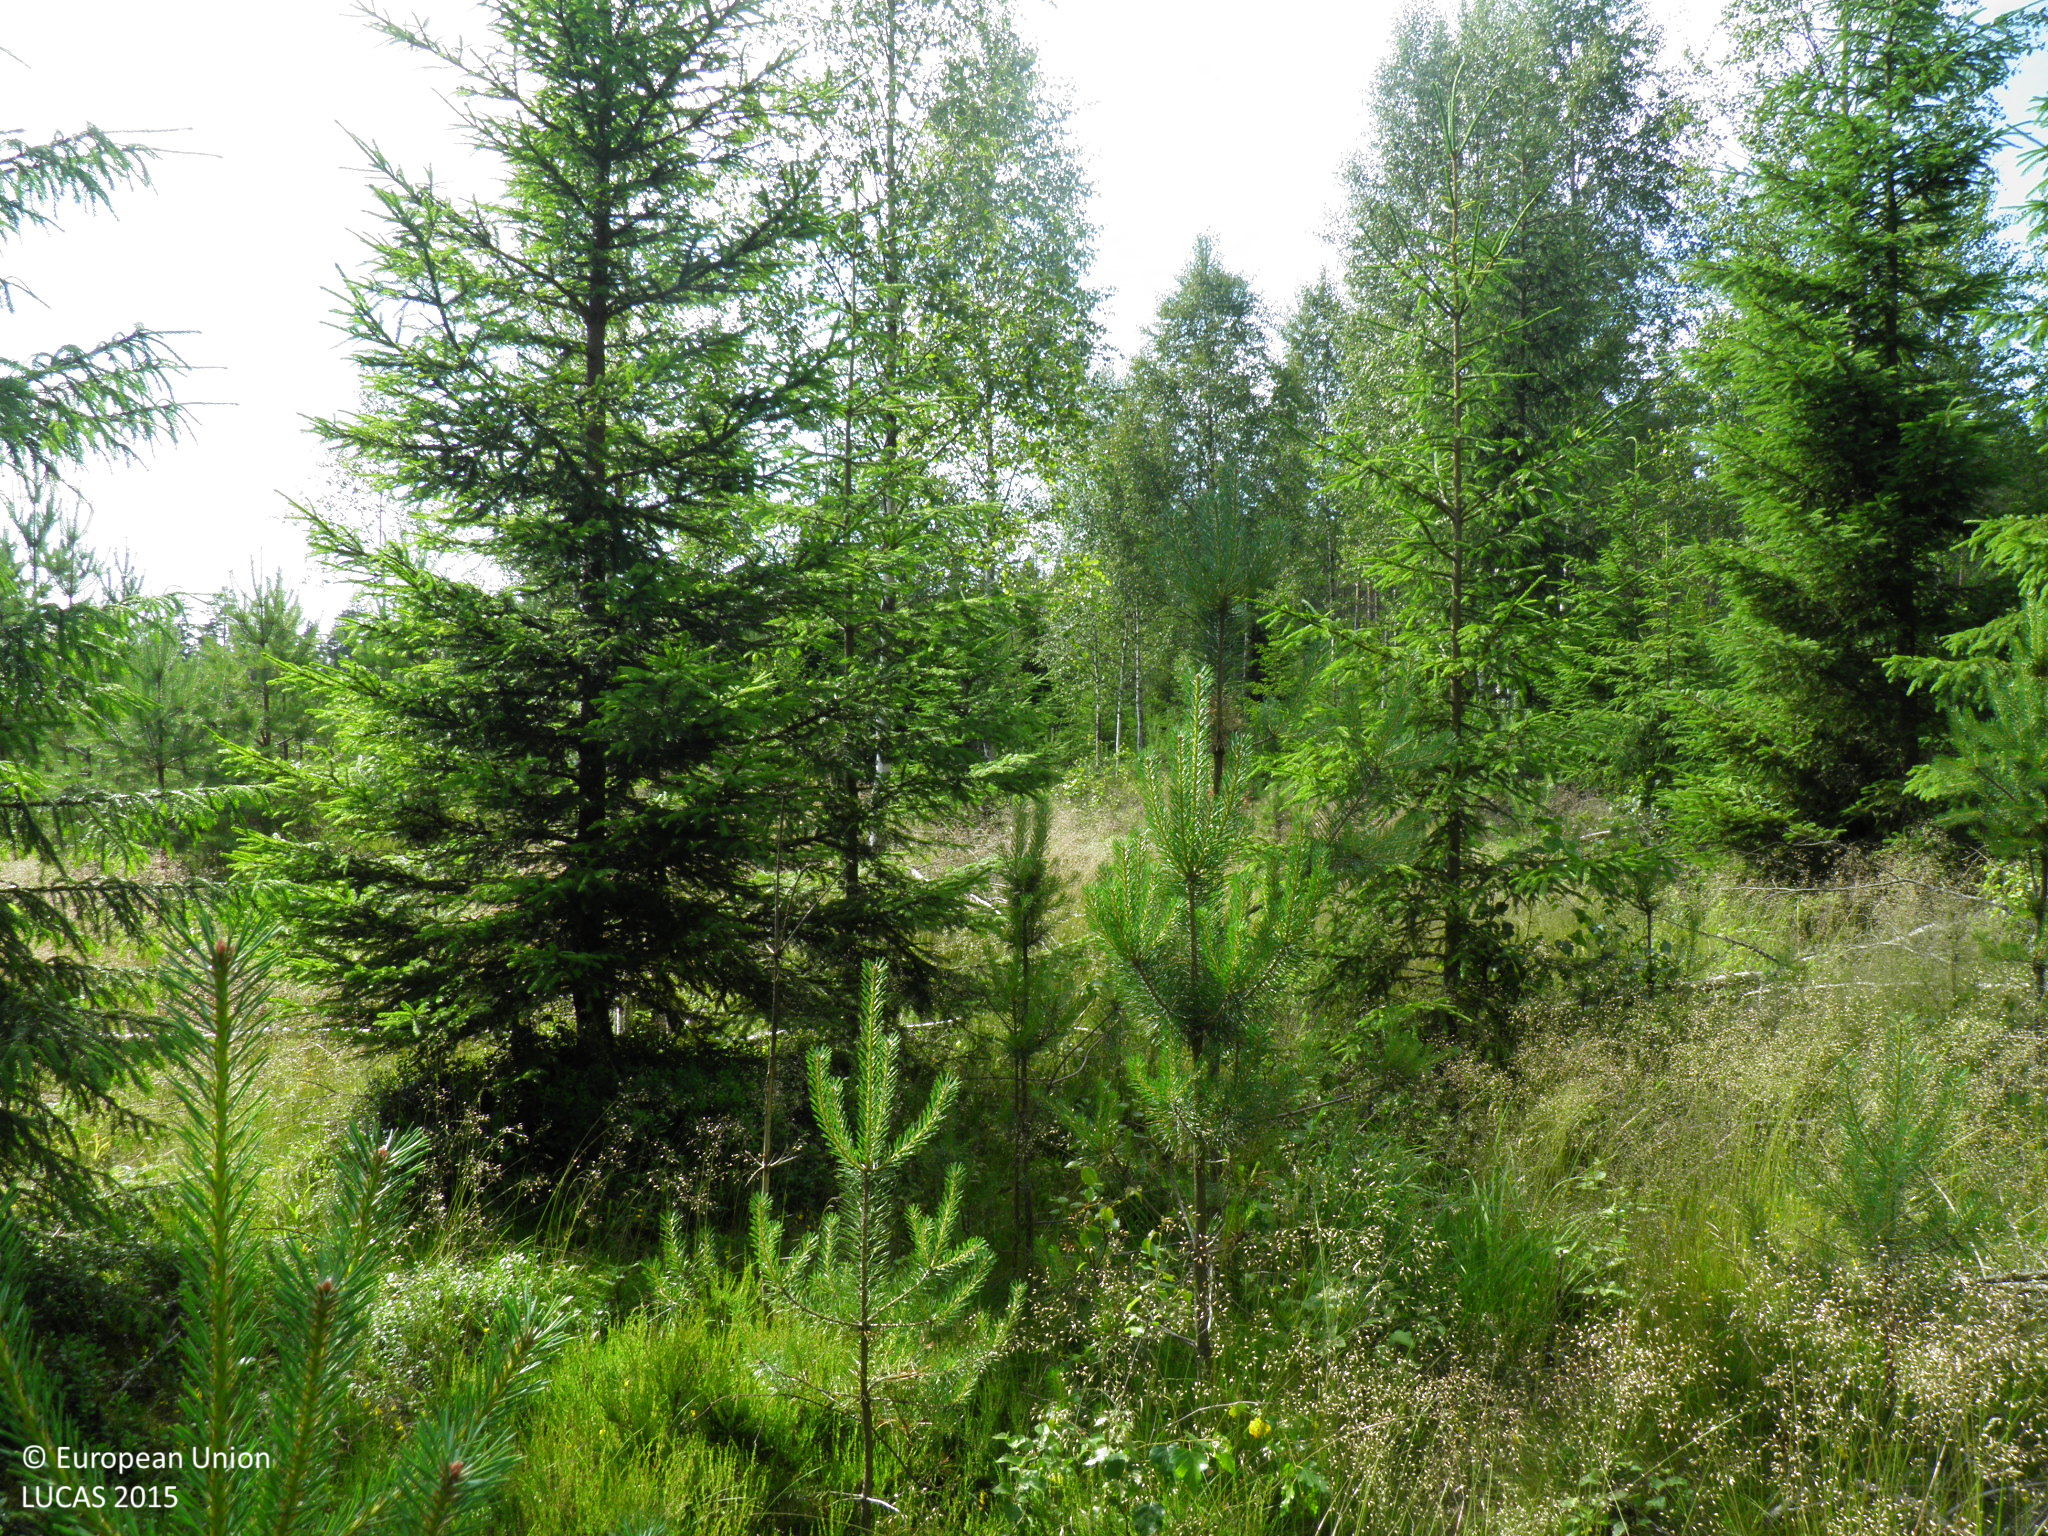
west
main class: Woodland
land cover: Spruce dominated mixed woodland
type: hemiboreal forest and nemoral coniferous forest and mixed broadleaved-coniferous forest
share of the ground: 25 - 50 %
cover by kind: shrubs 55 %, coniferous forest trees 20 %, broadleaved forest trees 20 %, herbaceous plants 5 %
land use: Forestry
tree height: > 5 m
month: July
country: FI
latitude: 60.7568
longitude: 22.6782
